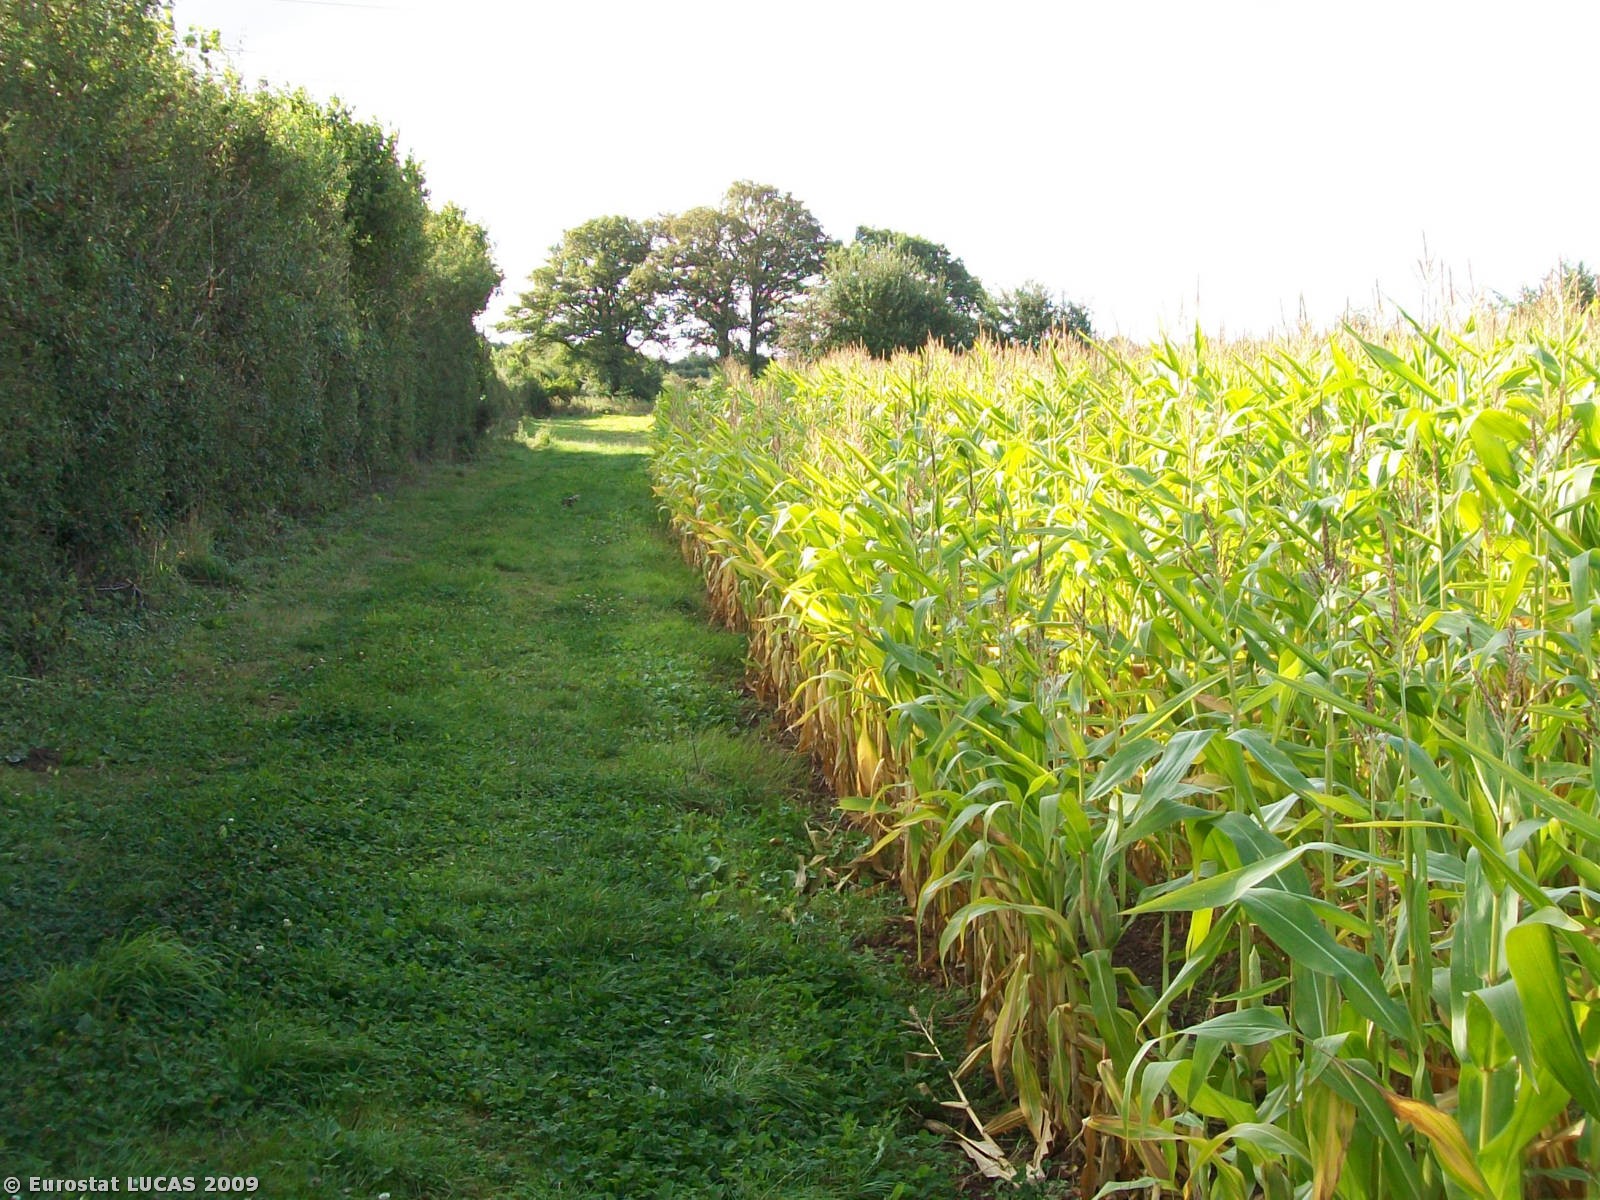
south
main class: Cropland
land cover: Maize
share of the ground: 25 - 50 %
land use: Agriculture (excluding fallow land and kitchen gardens)
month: September
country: GB
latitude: 52.1146
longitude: -2.4937
